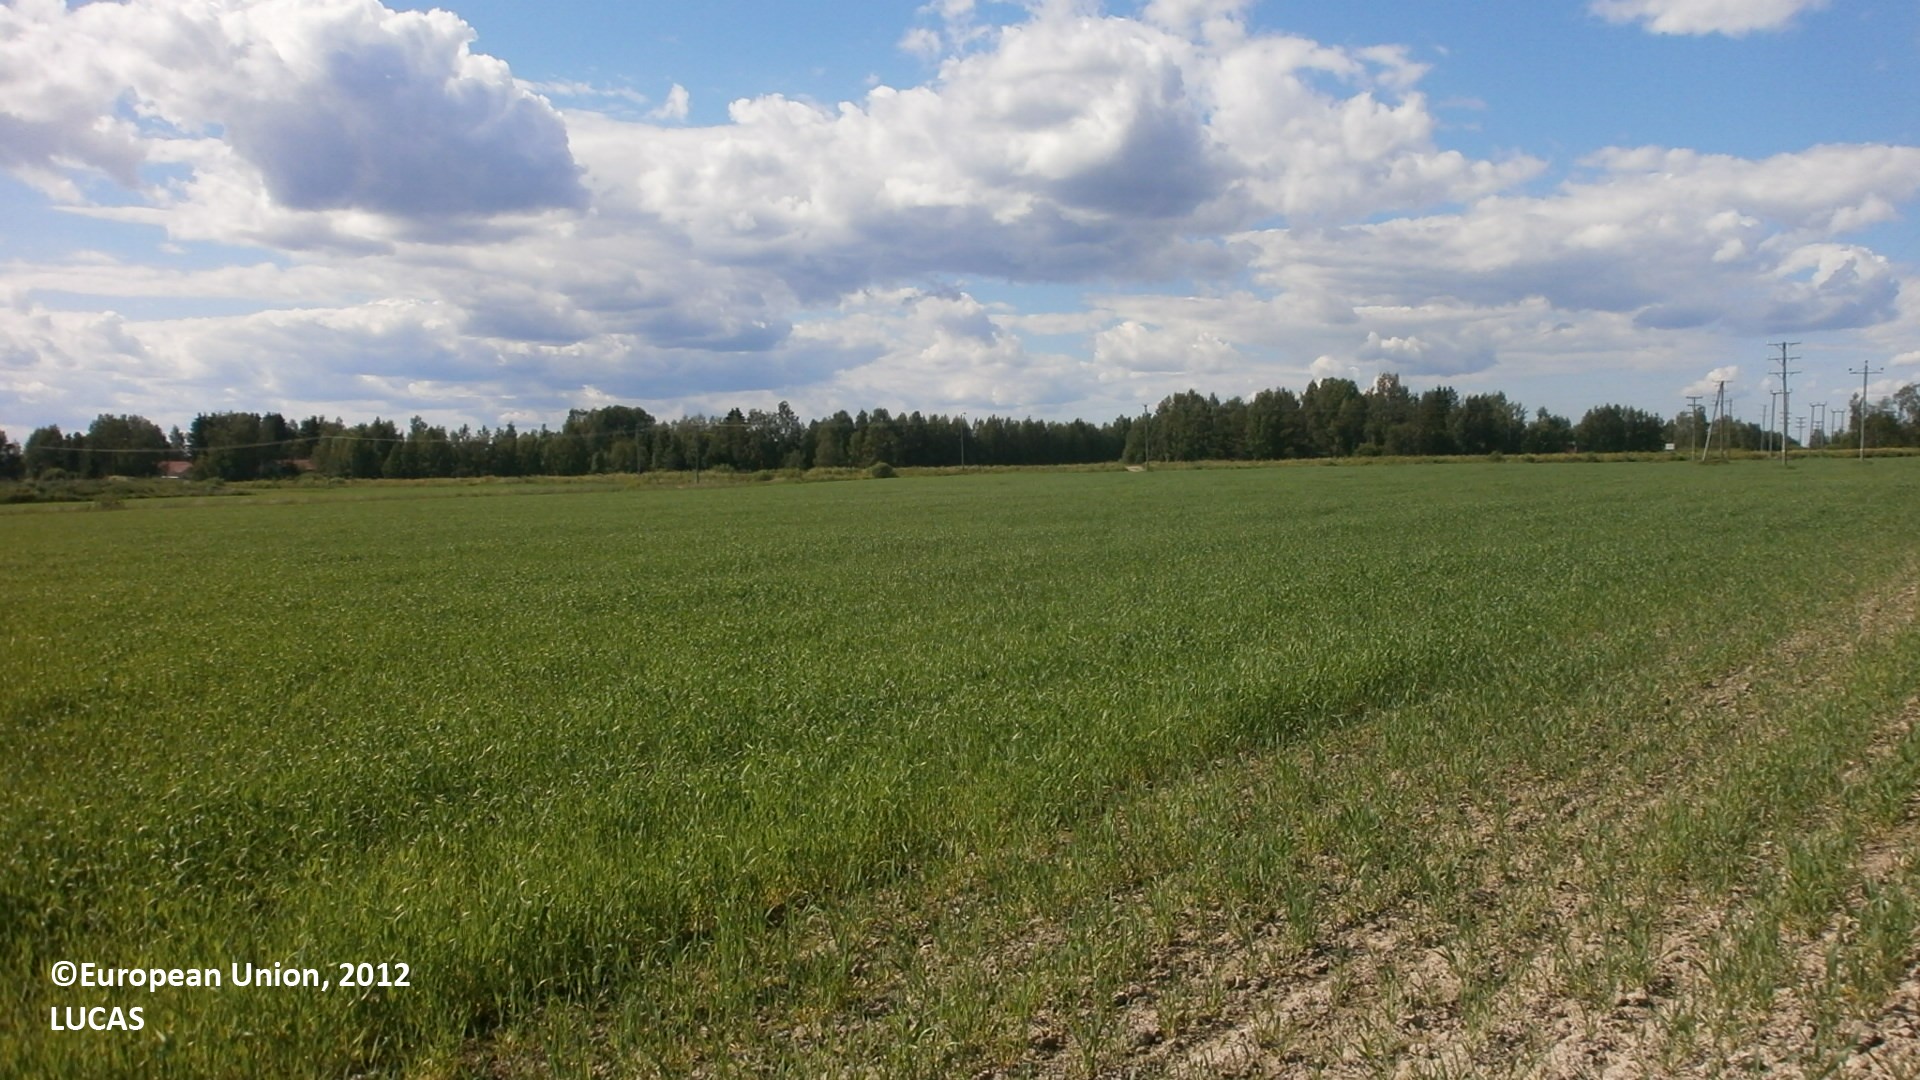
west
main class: Cropland
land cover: Barley
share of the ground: 25 - 50 %
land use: Agriculture (excluding fallow land and kitchen gardens)
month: July
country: FI
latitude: 63.9959
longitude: 24.7787
